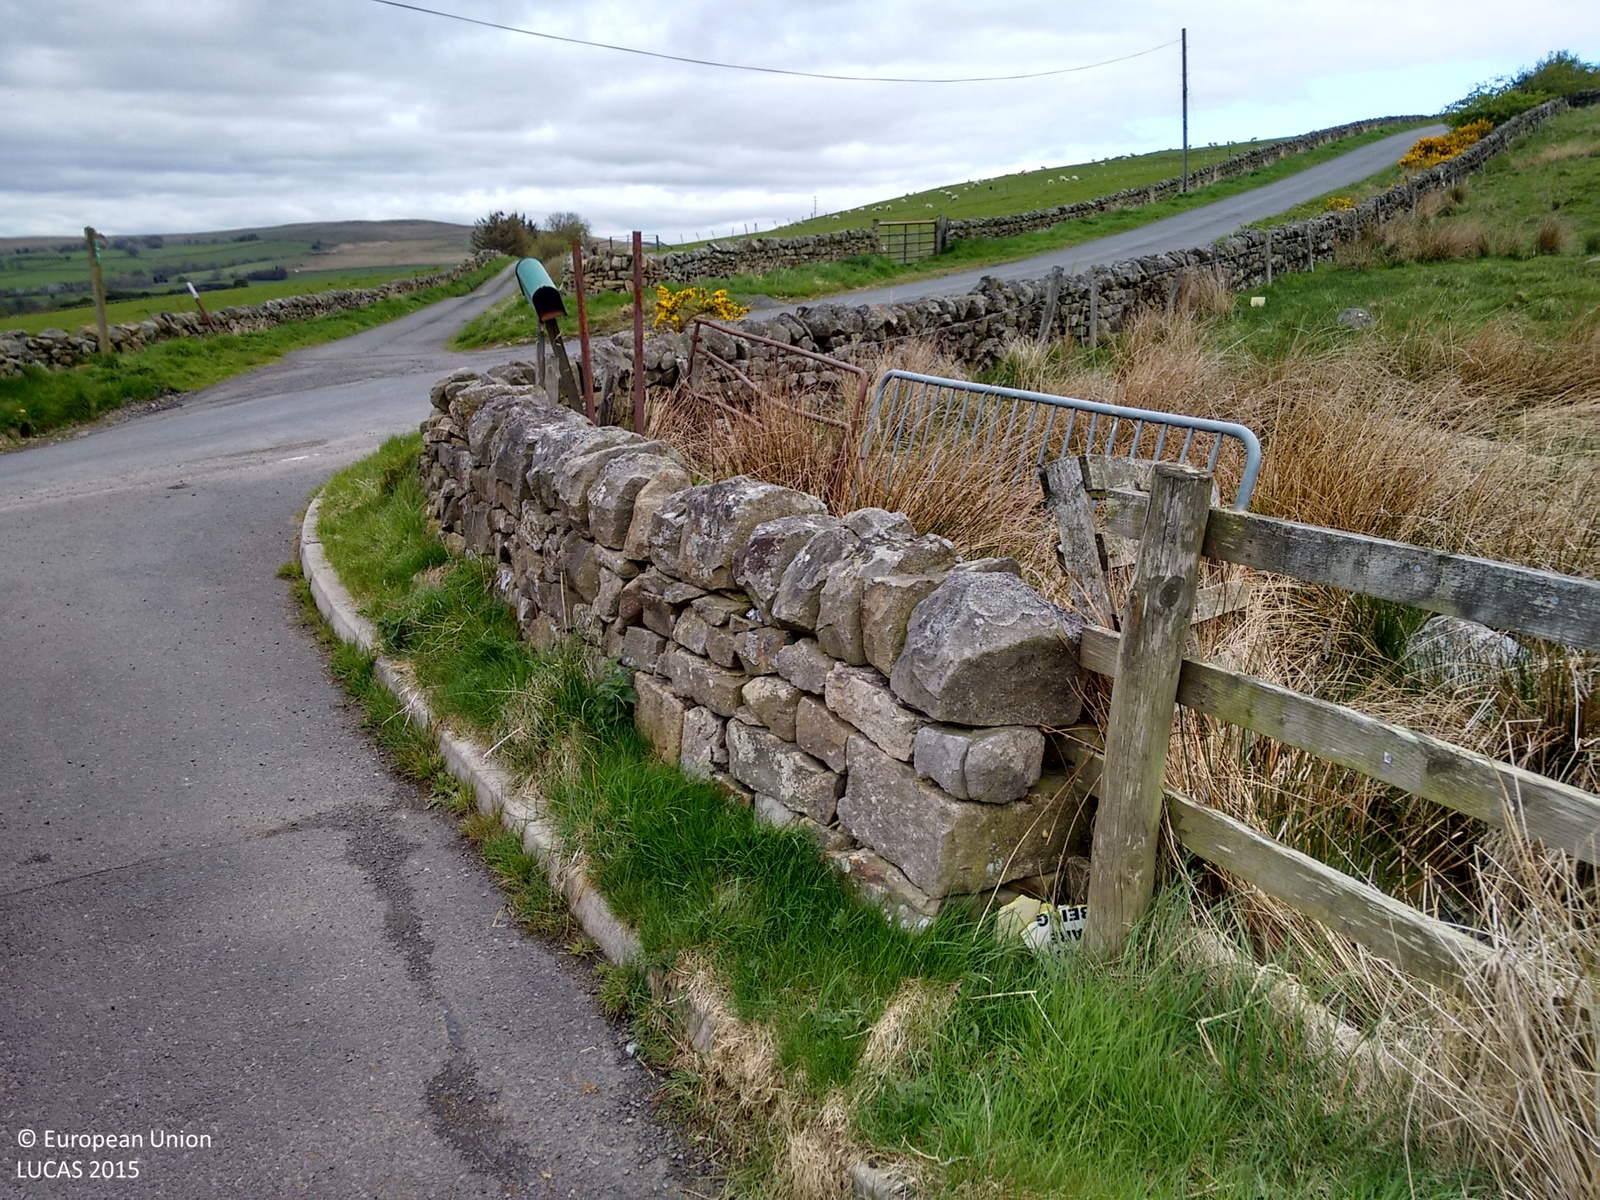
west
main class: Shrubland
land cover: Shrubland without tree cover
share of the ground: > 75 %
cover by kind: shrubs 100 %
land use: Semi-natural and natural areas not in use
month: May
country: GB
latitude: 55.1759
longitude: -2.0989
